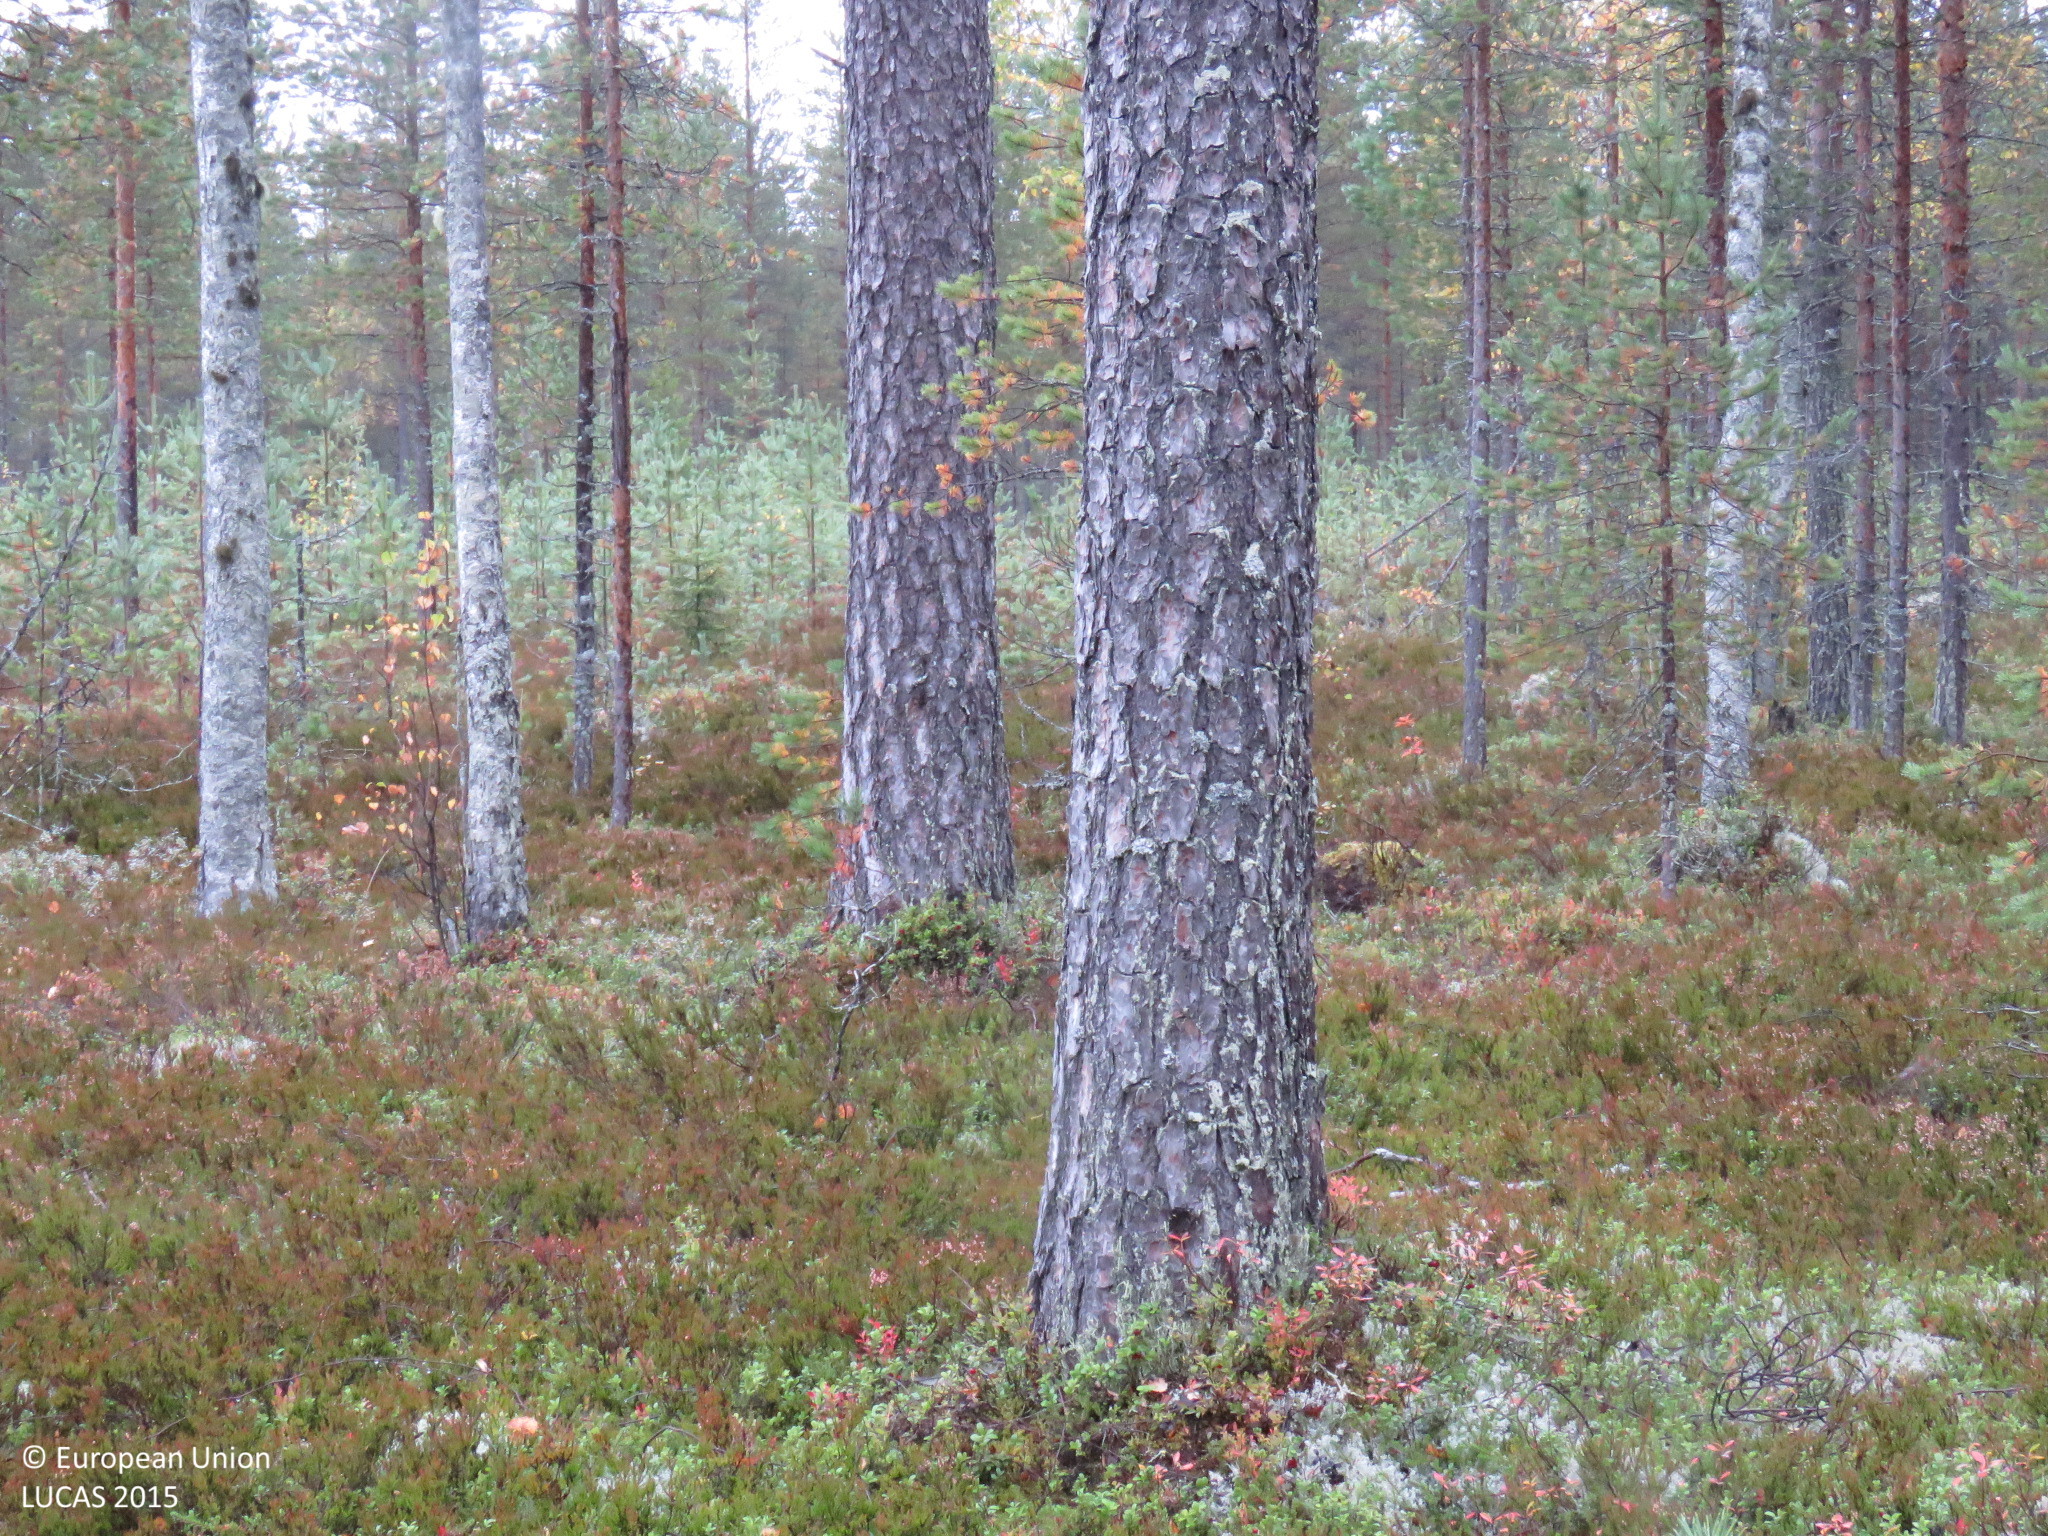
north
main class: Woodland
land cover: Other mixed woodland
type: boreal forest
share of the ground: 50 - 75 %
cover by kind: coniferous forest trees 45 %, broadleaved forest trees 25 %, shrubs 20 %, lichens and mosses 10 %
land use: Forestry
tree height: > 5 m
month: September
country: FI
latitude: 64.7960
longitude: 26.9387
